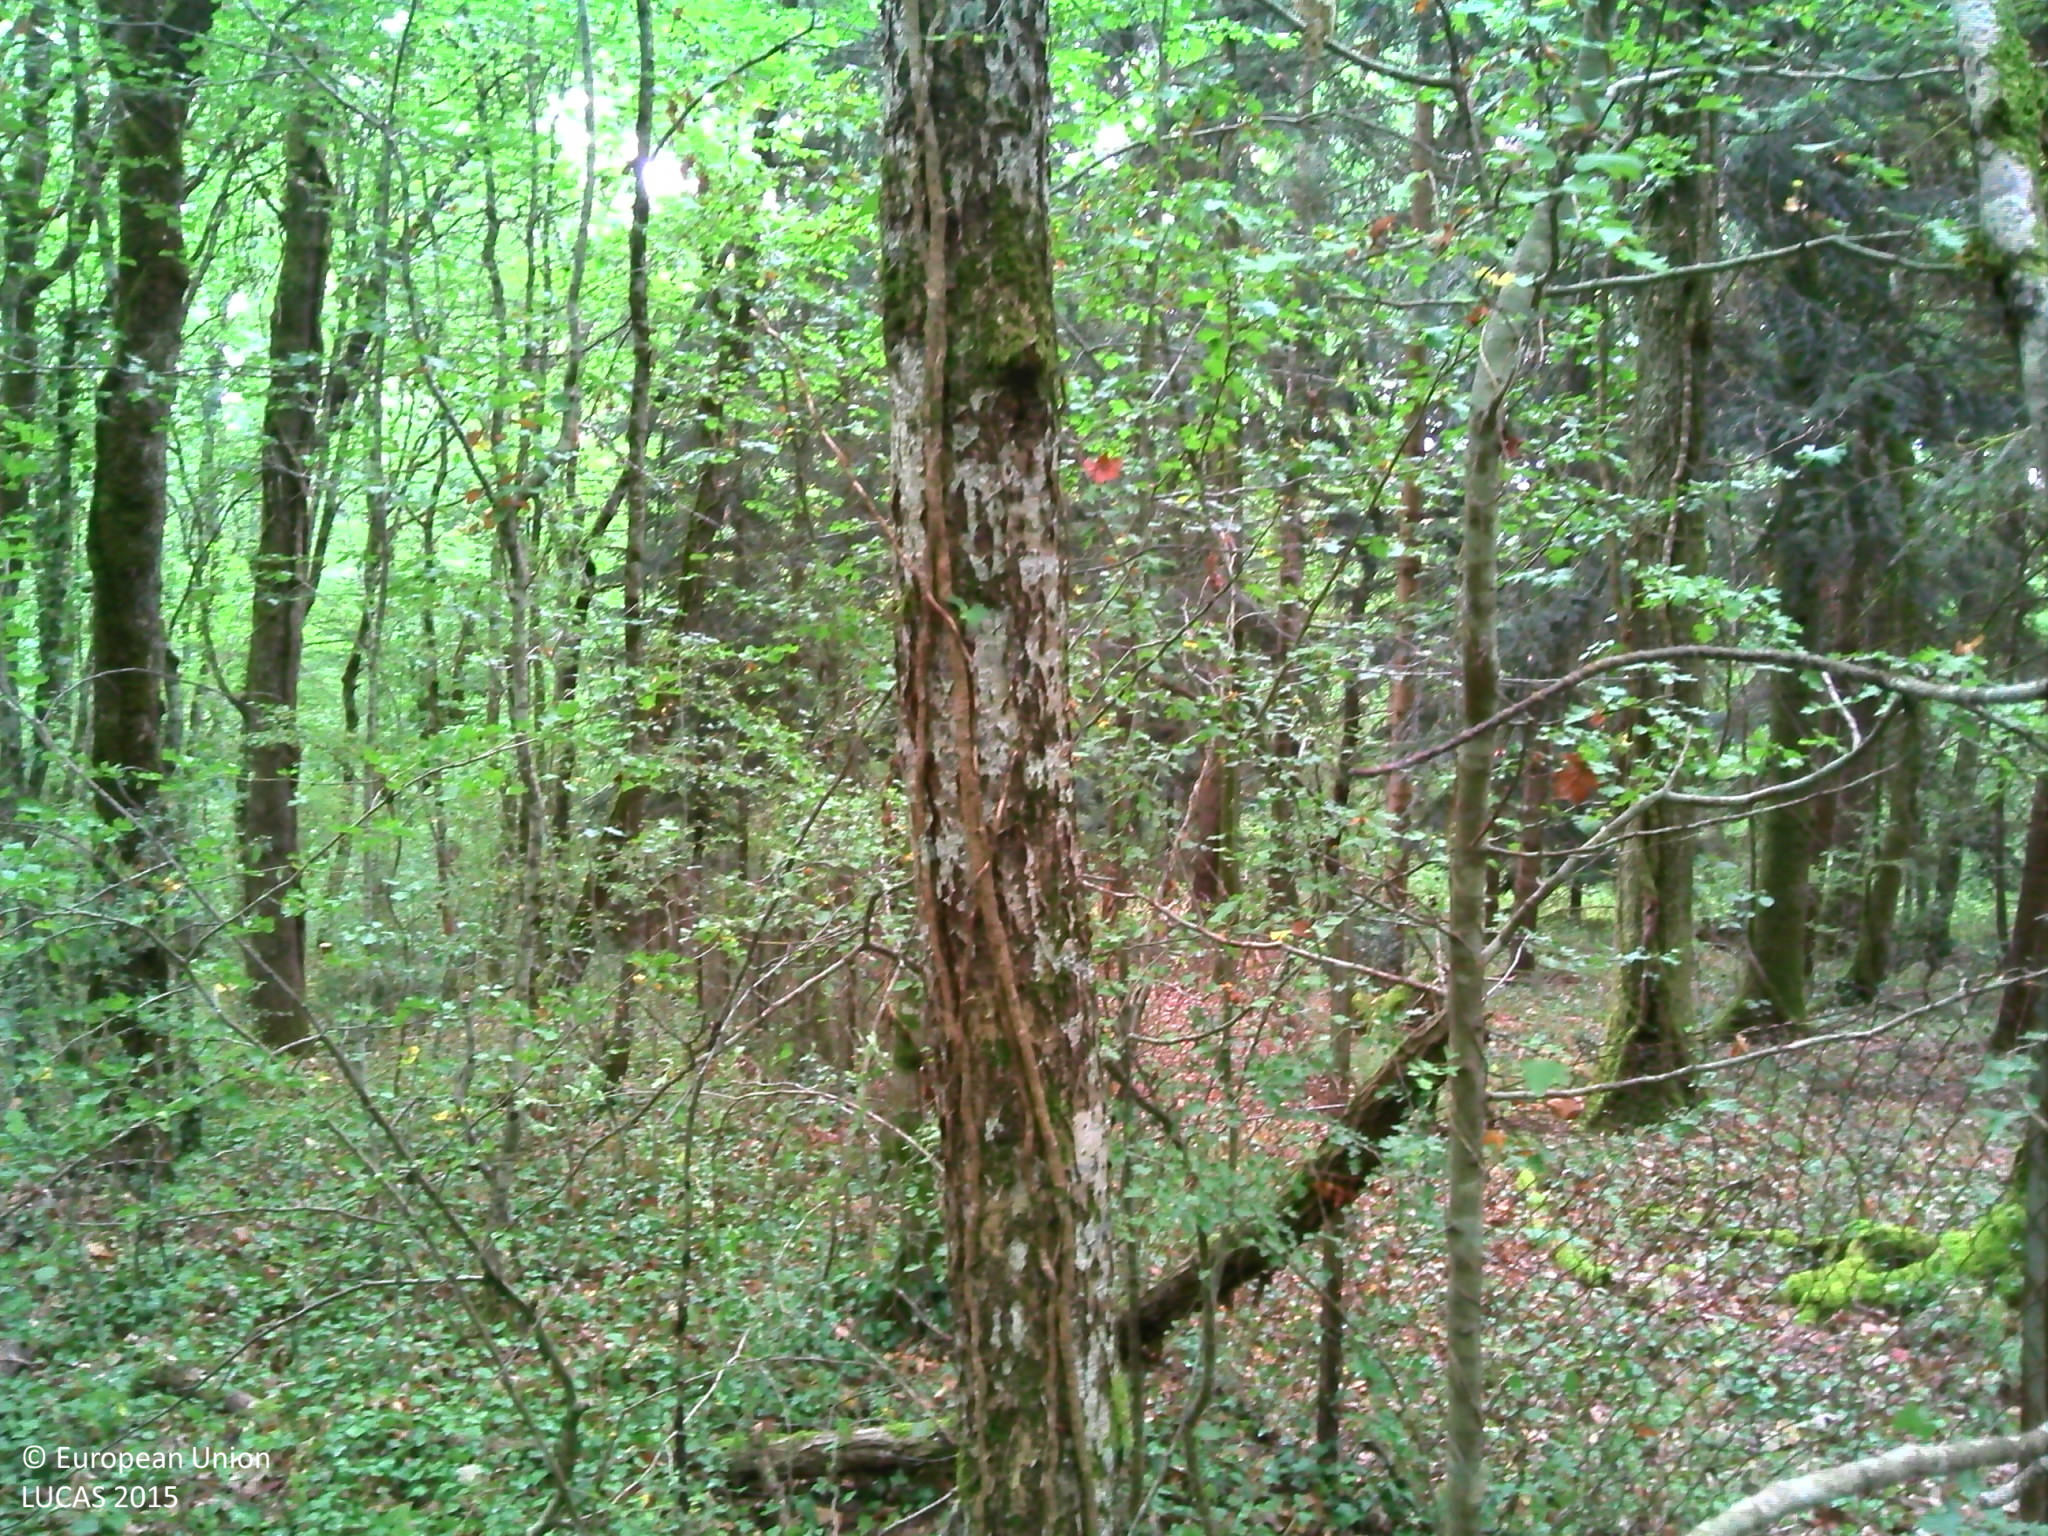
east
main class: Woodland
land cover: Broadleaved woodland
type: thermophilous deciduous forest
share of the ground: > 75 %
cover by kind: broadleaved forest trees 85 %, herbaceous plants 15 %
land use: Forestry
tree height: > 5 m
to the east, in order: Broadleaved woodland; Fences; Broadleaved woodland; Rivers and streams; Grassland without tree/shrub cover; Tracks; Managed hedges; Grassland with sparse tree/shrub cover; Managed hedges; Grass margins; Paved roads, cycling and walking lanes
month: August
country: FR
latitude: 44.2376
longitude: 0.6667
